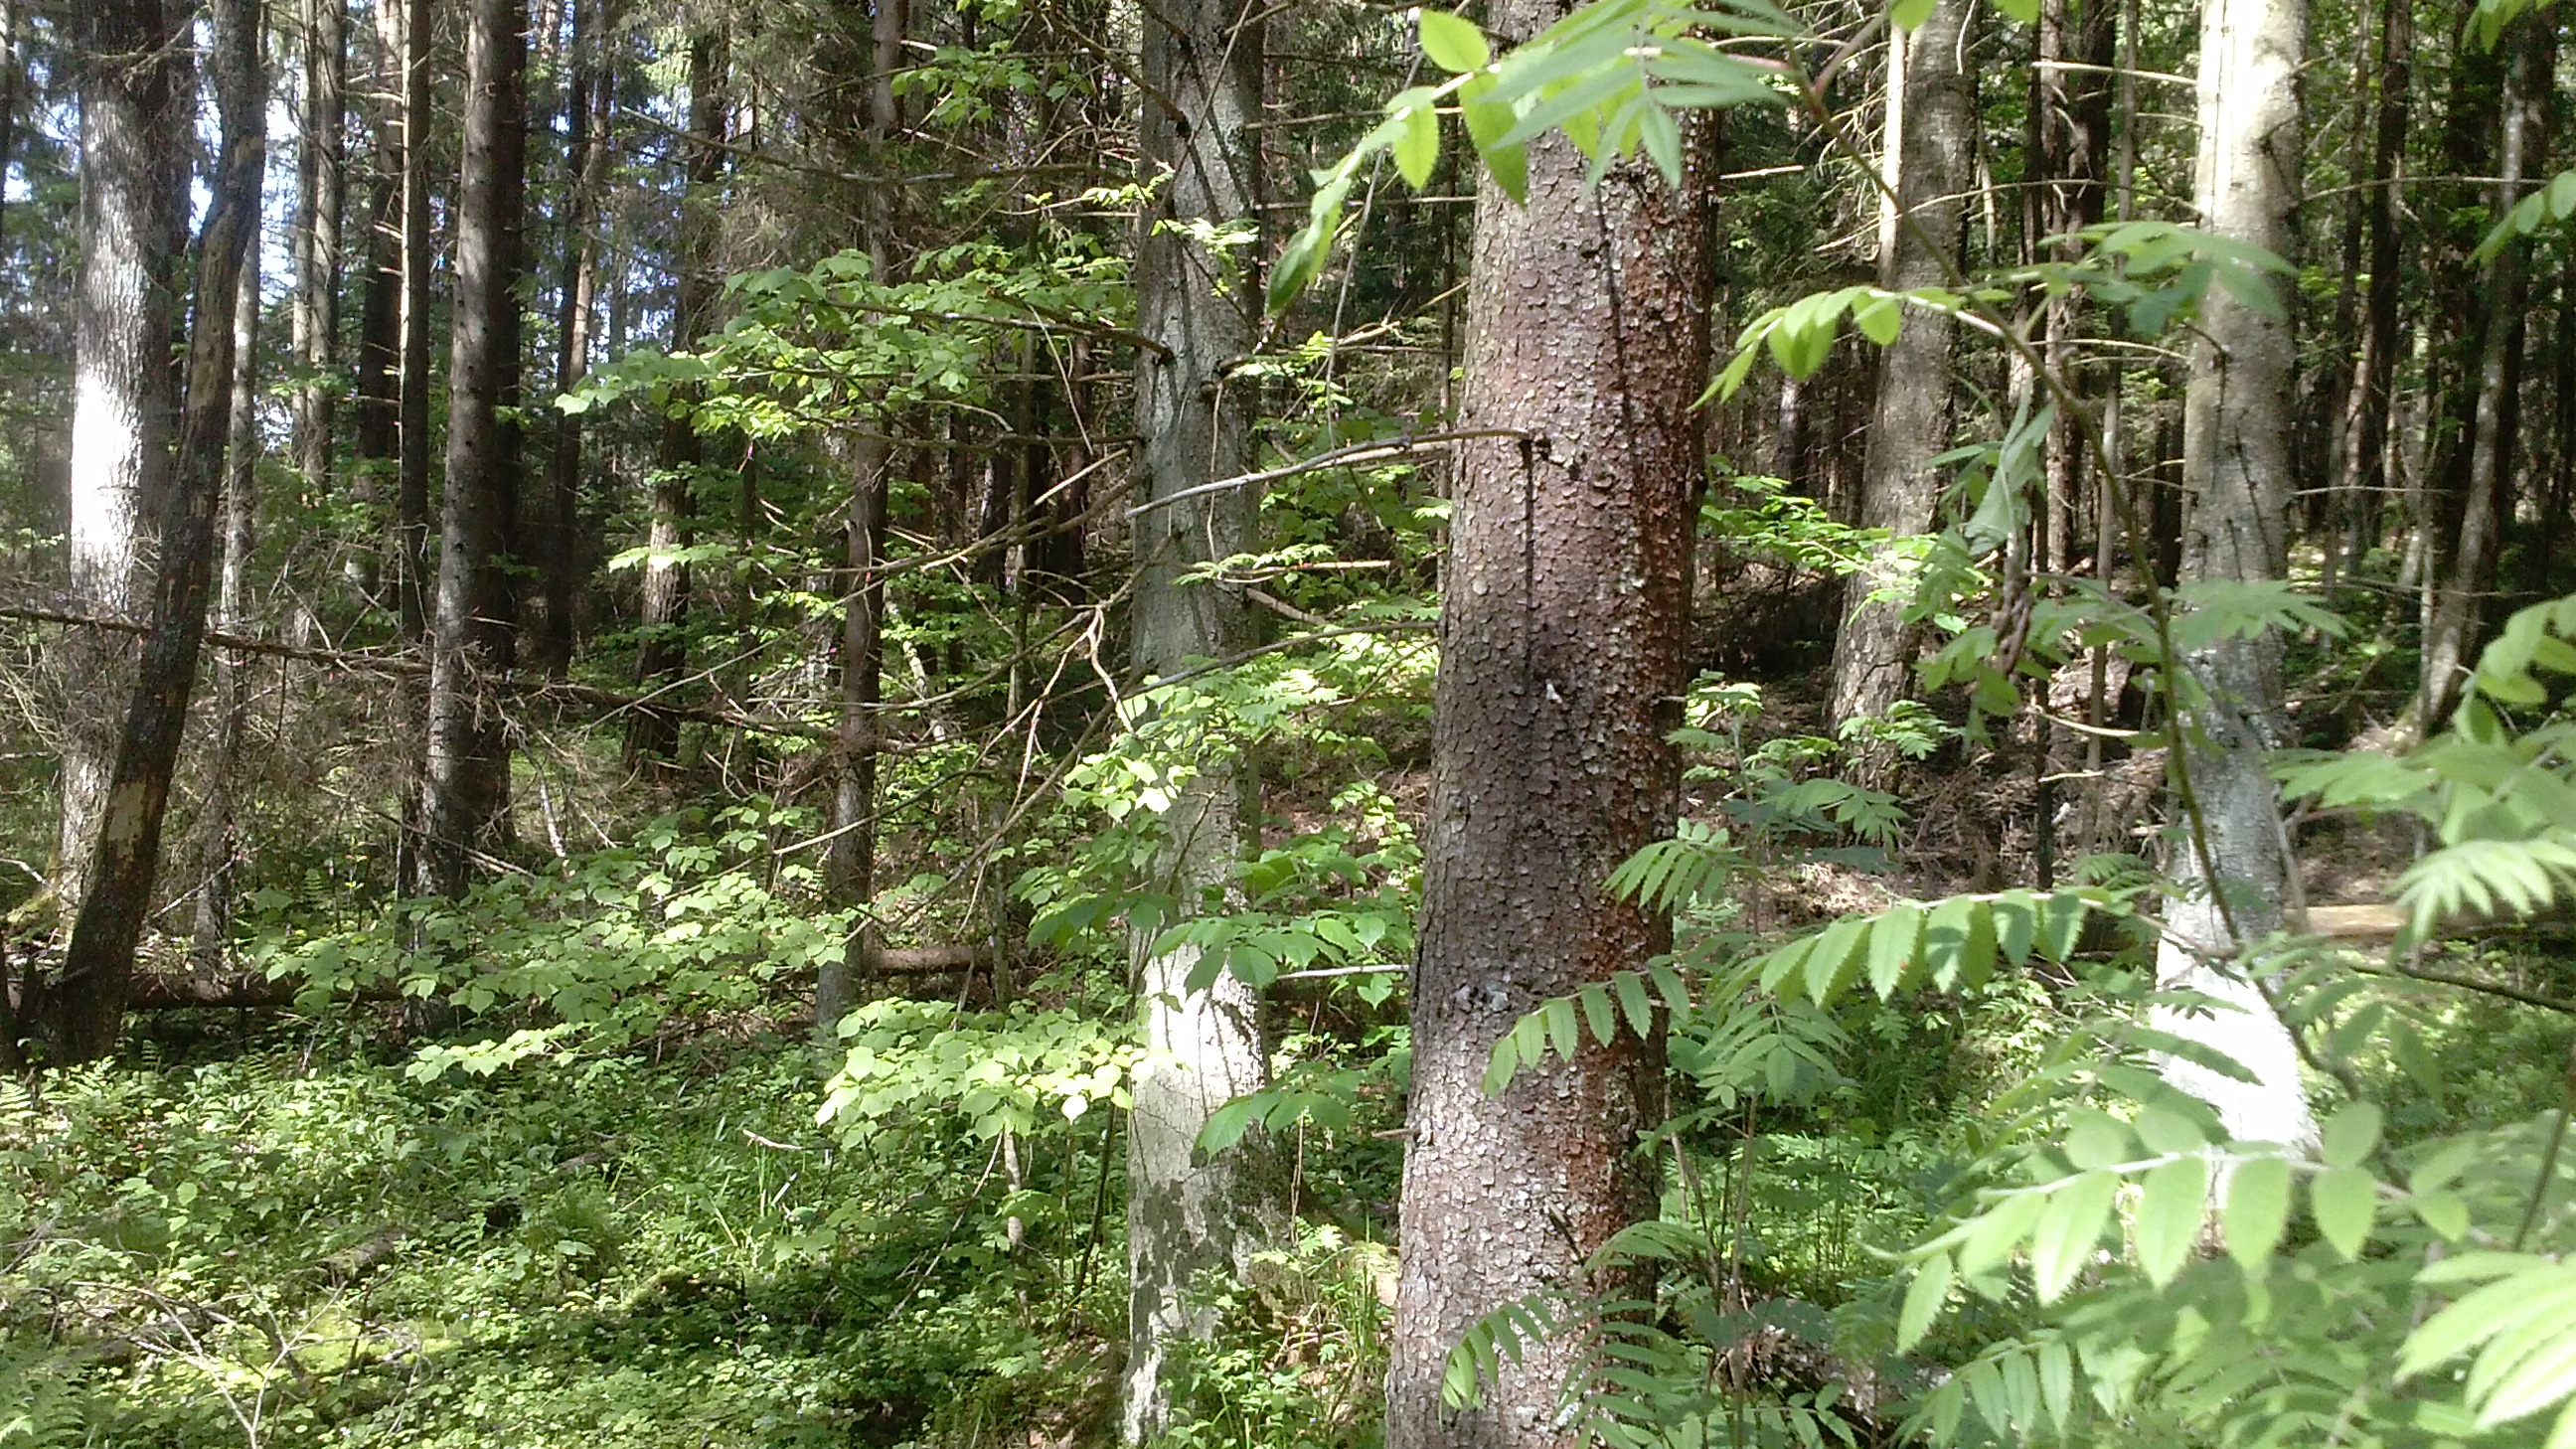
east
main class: Woodland
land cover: Spruce dominated coniferous woodland
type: hemiboreal forest and nemoral coniferous forest and mixed broadleaved-coniferous forest
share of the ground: > 75 %
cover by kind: coniferous forest trees 95 %, broadleaved forest trees 5 %
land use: Forestry
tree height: > 5 m
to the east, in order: Spruce dominated coniferous woodland; Spruce dominated mixed woodland; Spruce dominated coniferous woodland
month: May
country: LV
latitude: 56.2835
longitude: 27.2126
